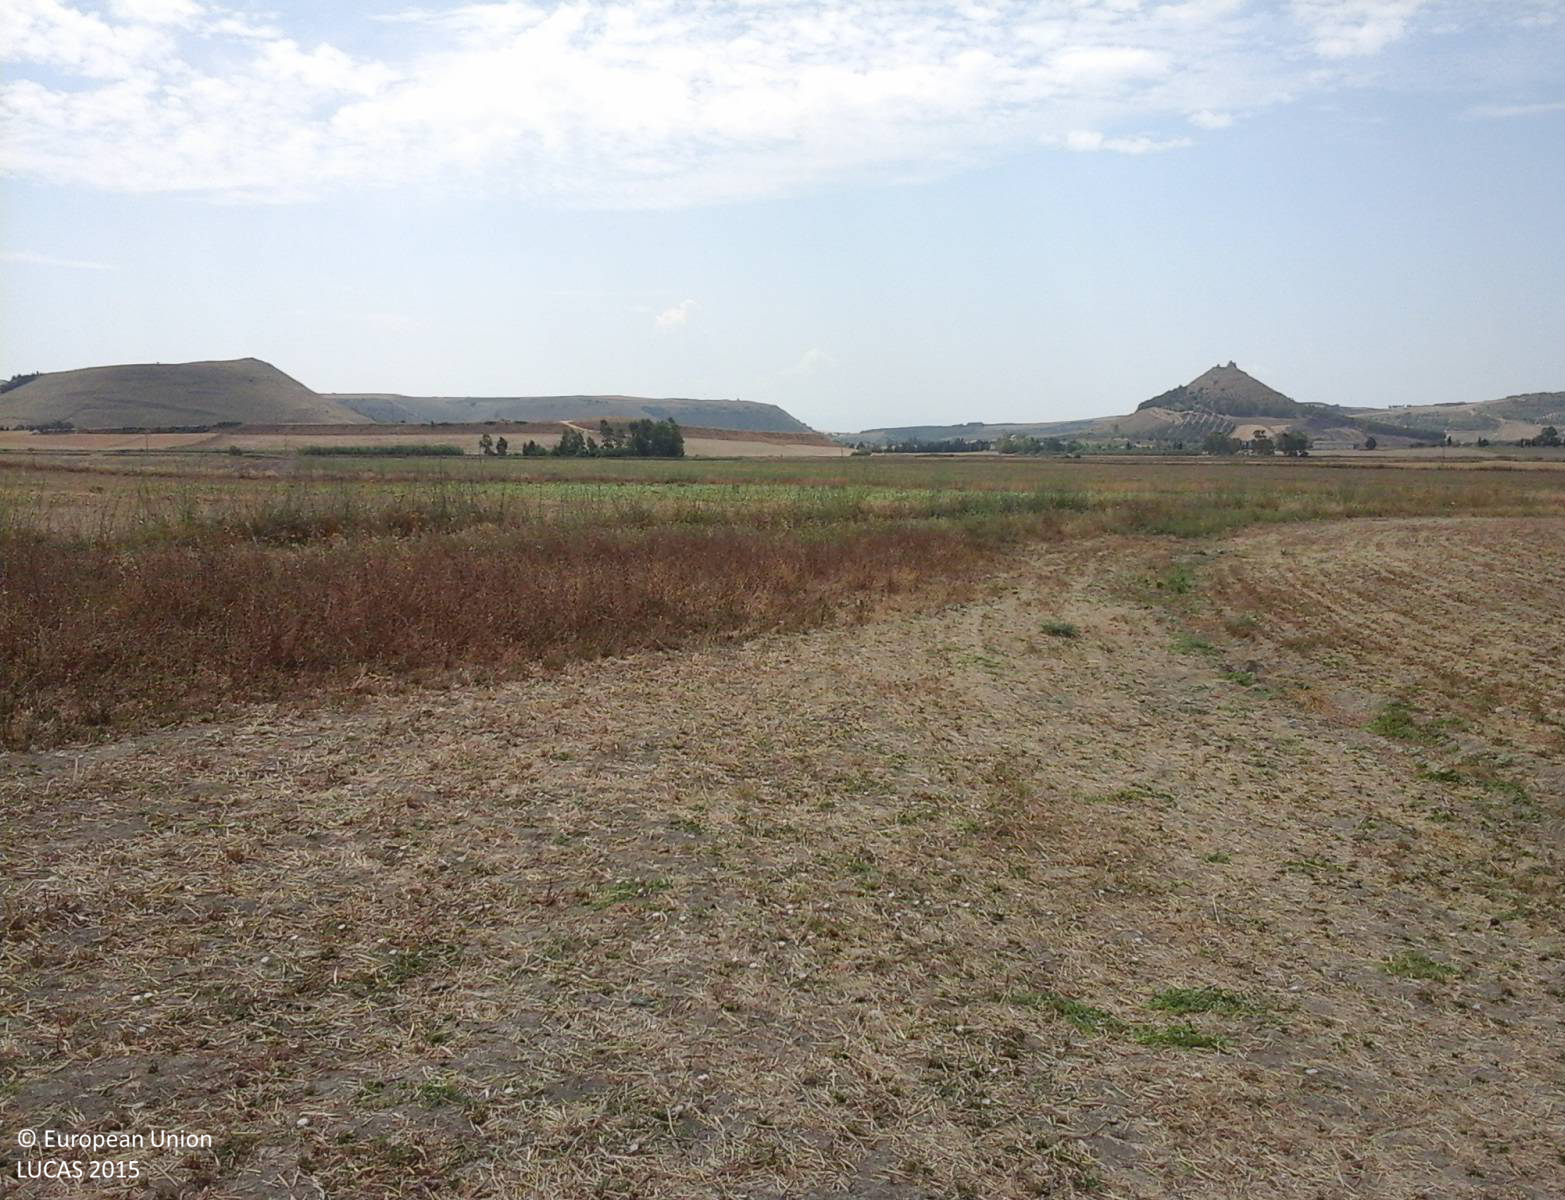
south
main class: Cropland
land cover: Temporary grasslands
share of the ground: > 75 %
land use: Agriculture (excluding fallow land and kitchen gardens)
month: July
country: IT
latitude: 39.7008
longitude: 8.9912
